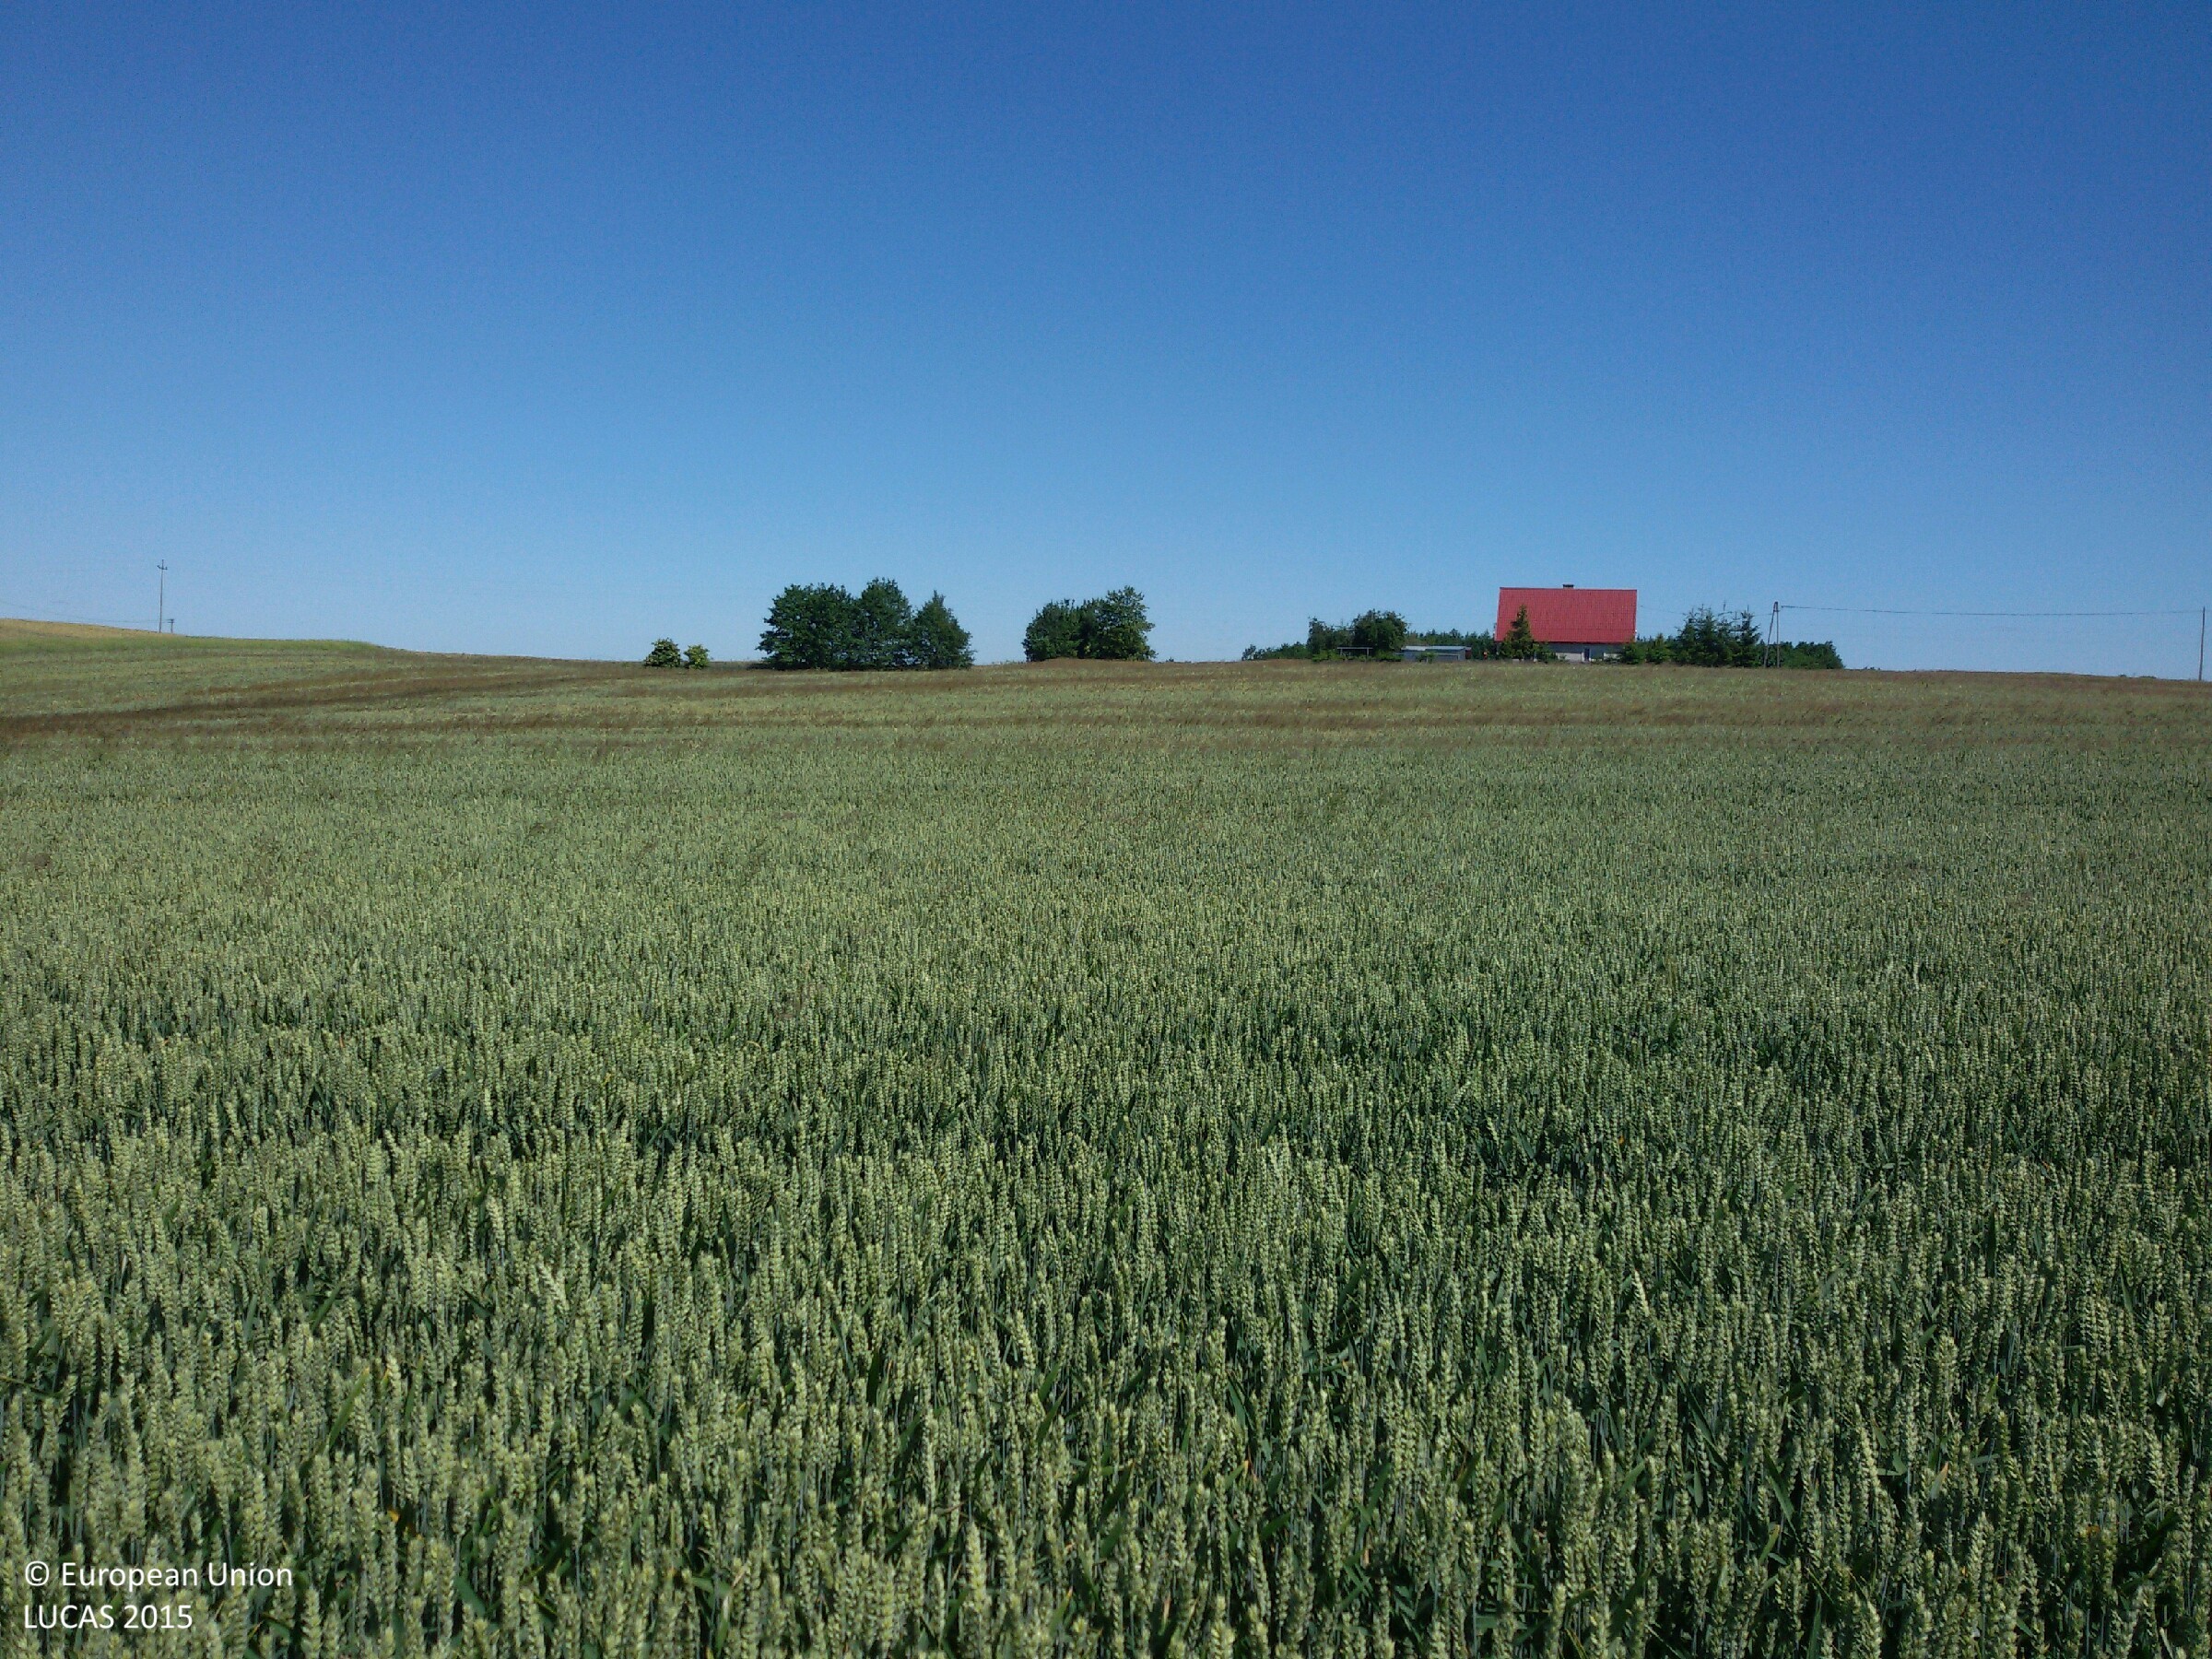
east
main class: Cropland
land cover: Common wheat
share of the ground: > 75 %
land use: Agriculture (excluding fallow land and kitchen gardens)
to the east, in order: Common wheat; Triticale
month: July
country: PL
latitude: 53.7857
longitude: 19.2981
